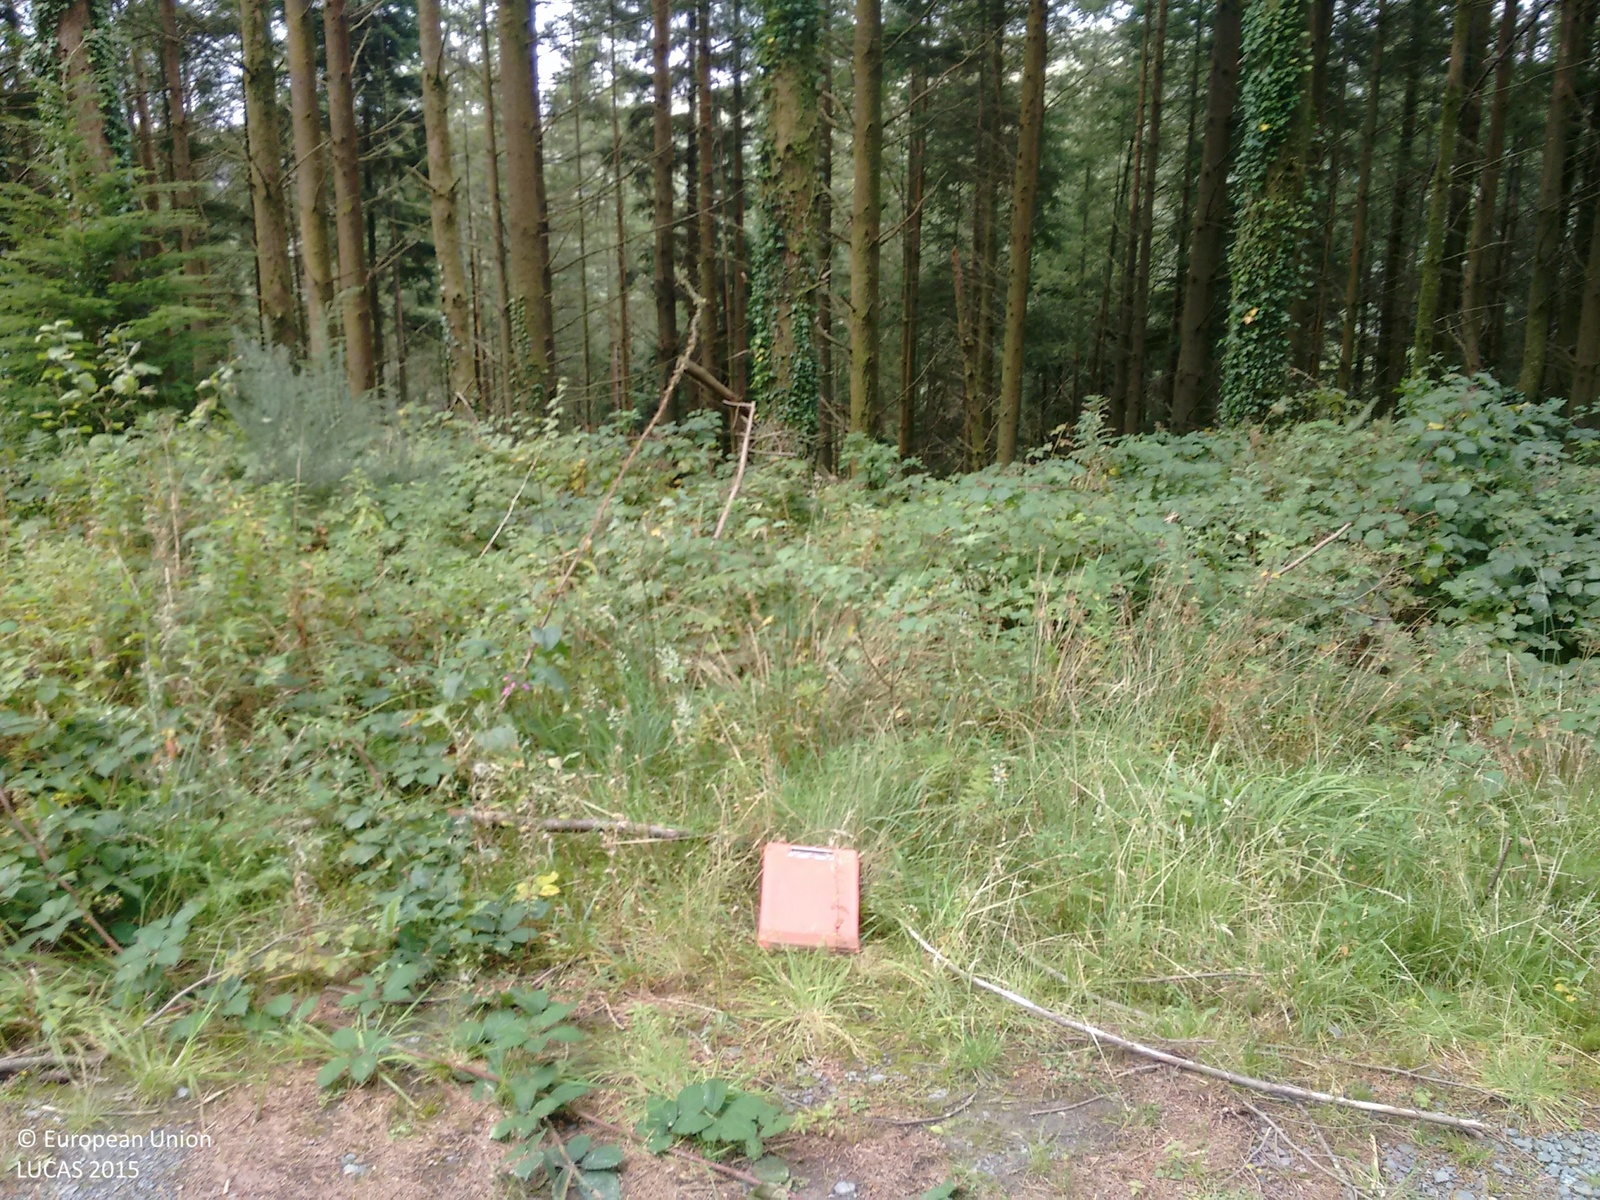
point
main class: Woodland
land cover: Other coniferous woodland
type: exotic forest
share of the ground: > 75 %
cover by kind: coniferous forest trees 100 %
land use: Forestry
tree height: > 5 m
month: September
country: GB
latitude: 52.6897
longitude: -3.7144
